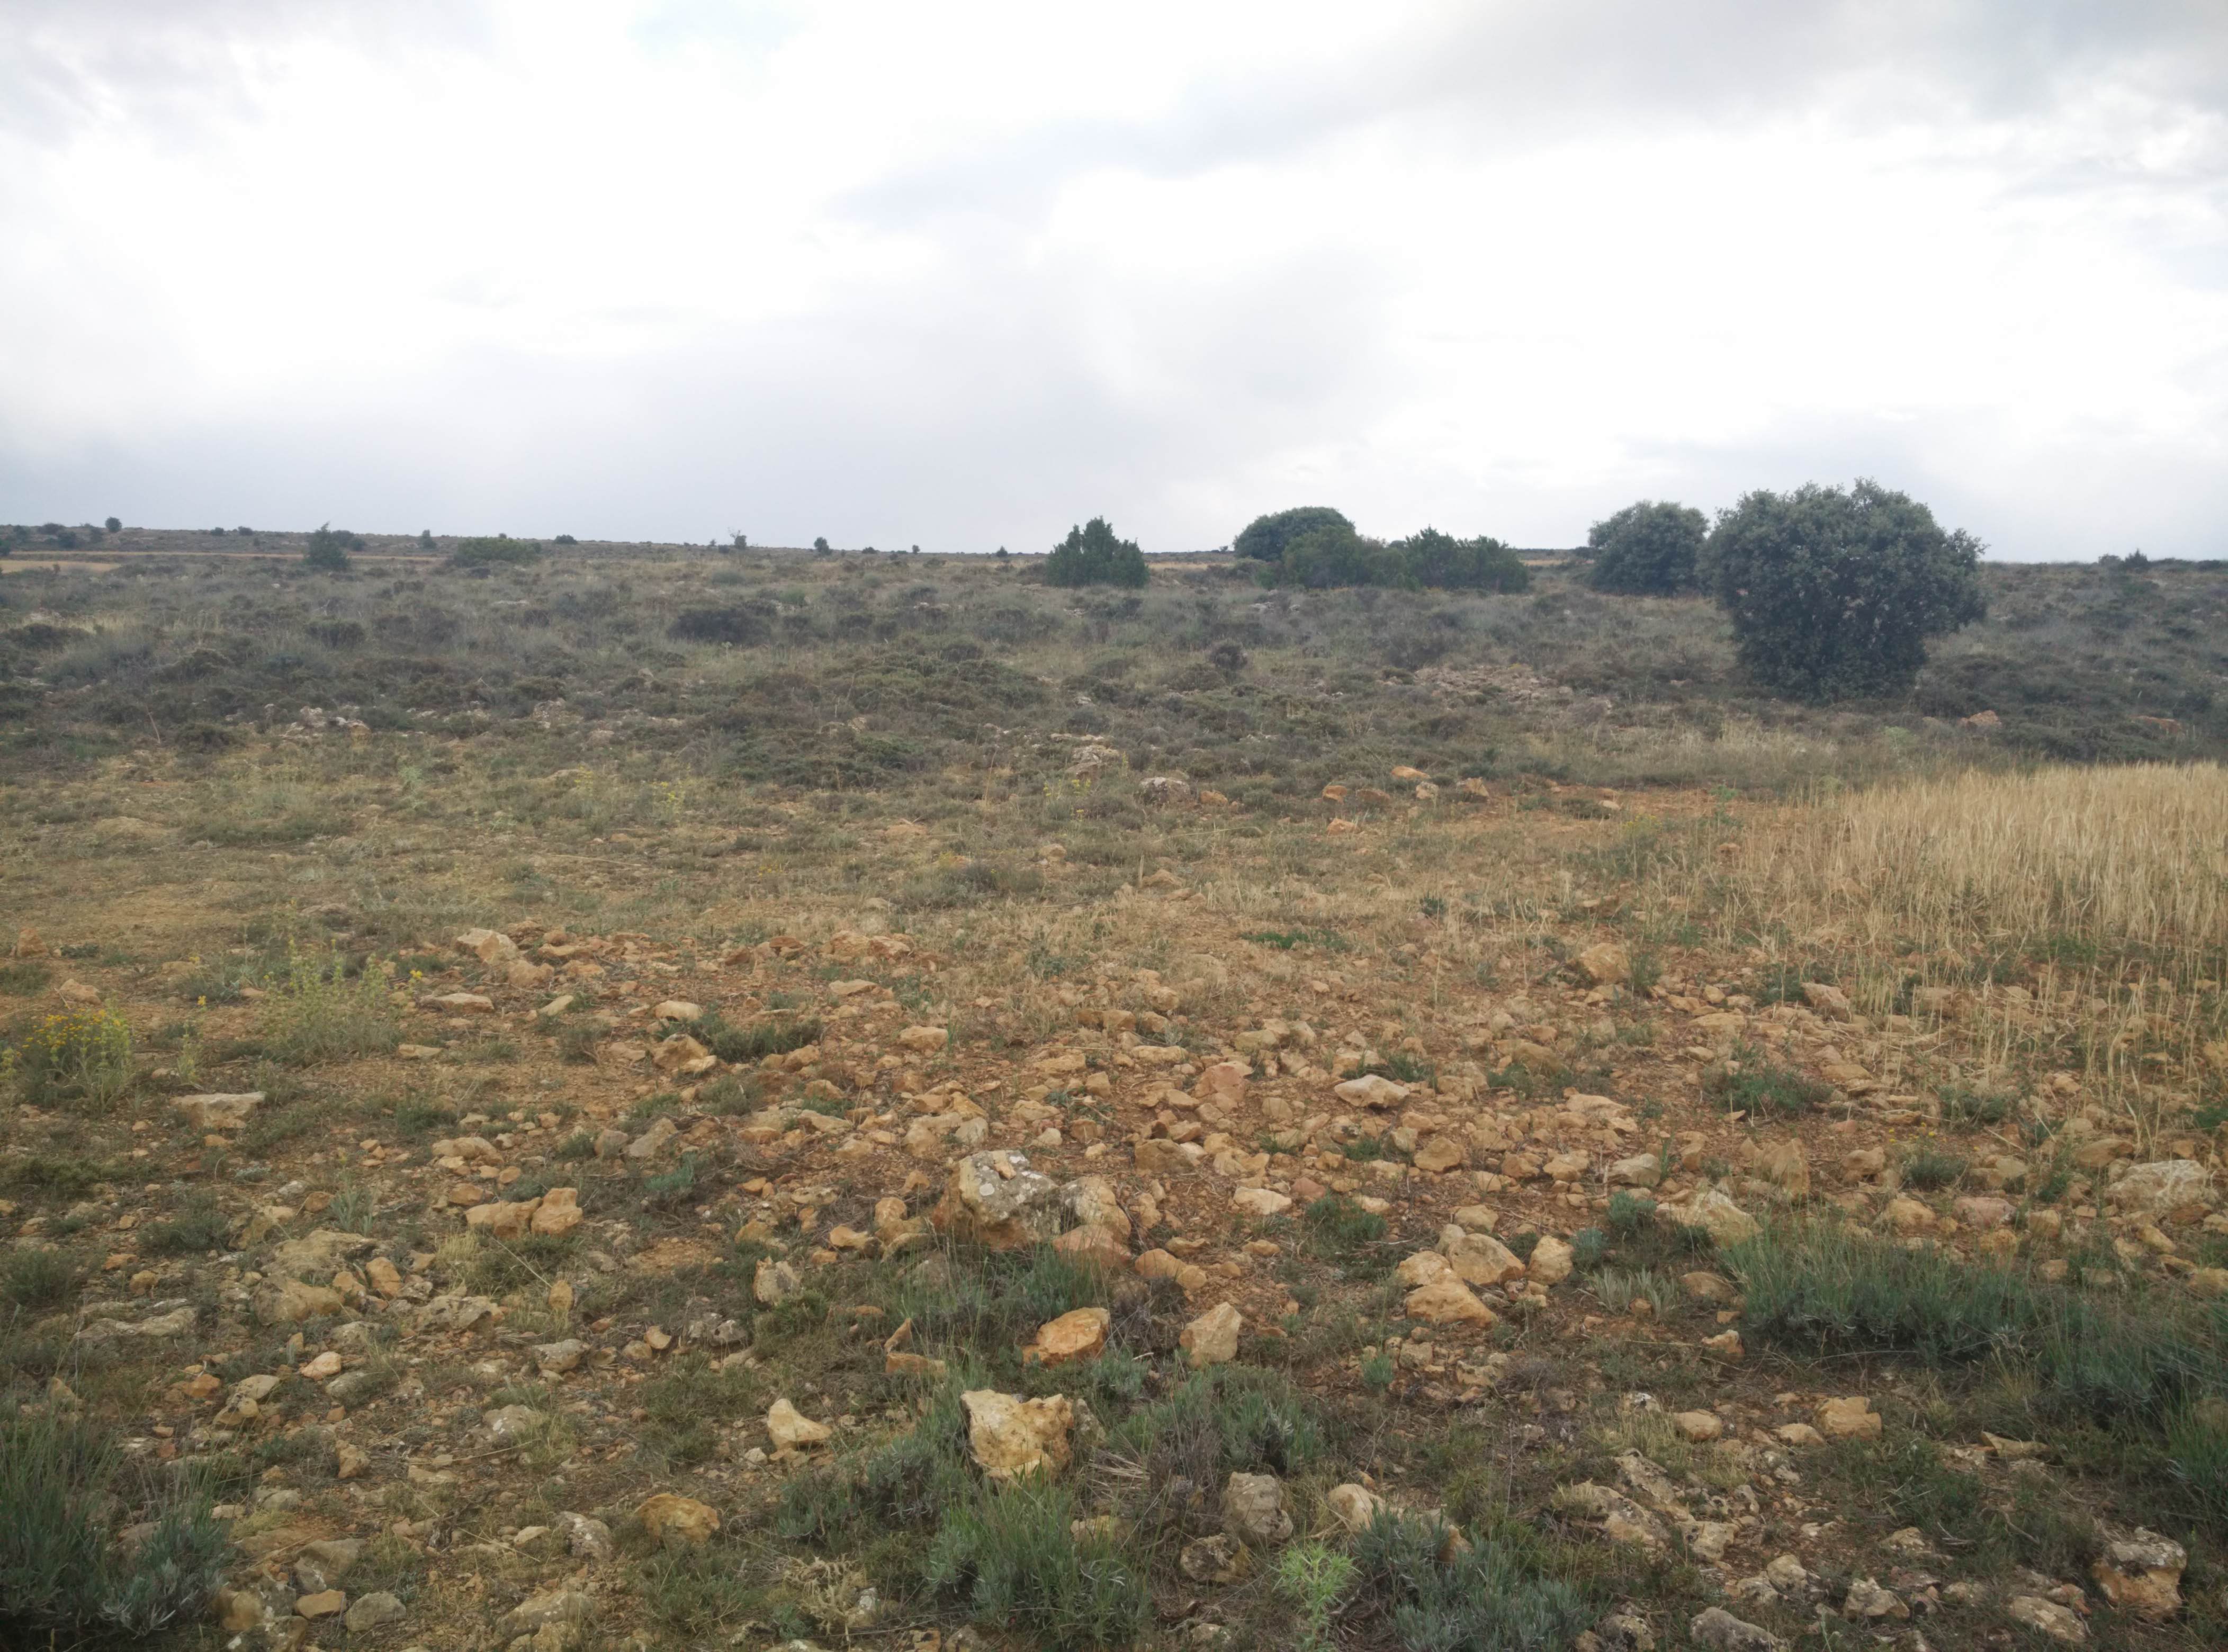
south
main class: Shrubland
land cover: Shrubland without tree cover
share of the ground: > 75 %
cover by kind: shrubs 80 %, unconsolidated bare surface 20 %
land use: Semi-natural and natural areas not in use
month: July
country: ES
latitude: 41.0602
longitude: -1.8641
